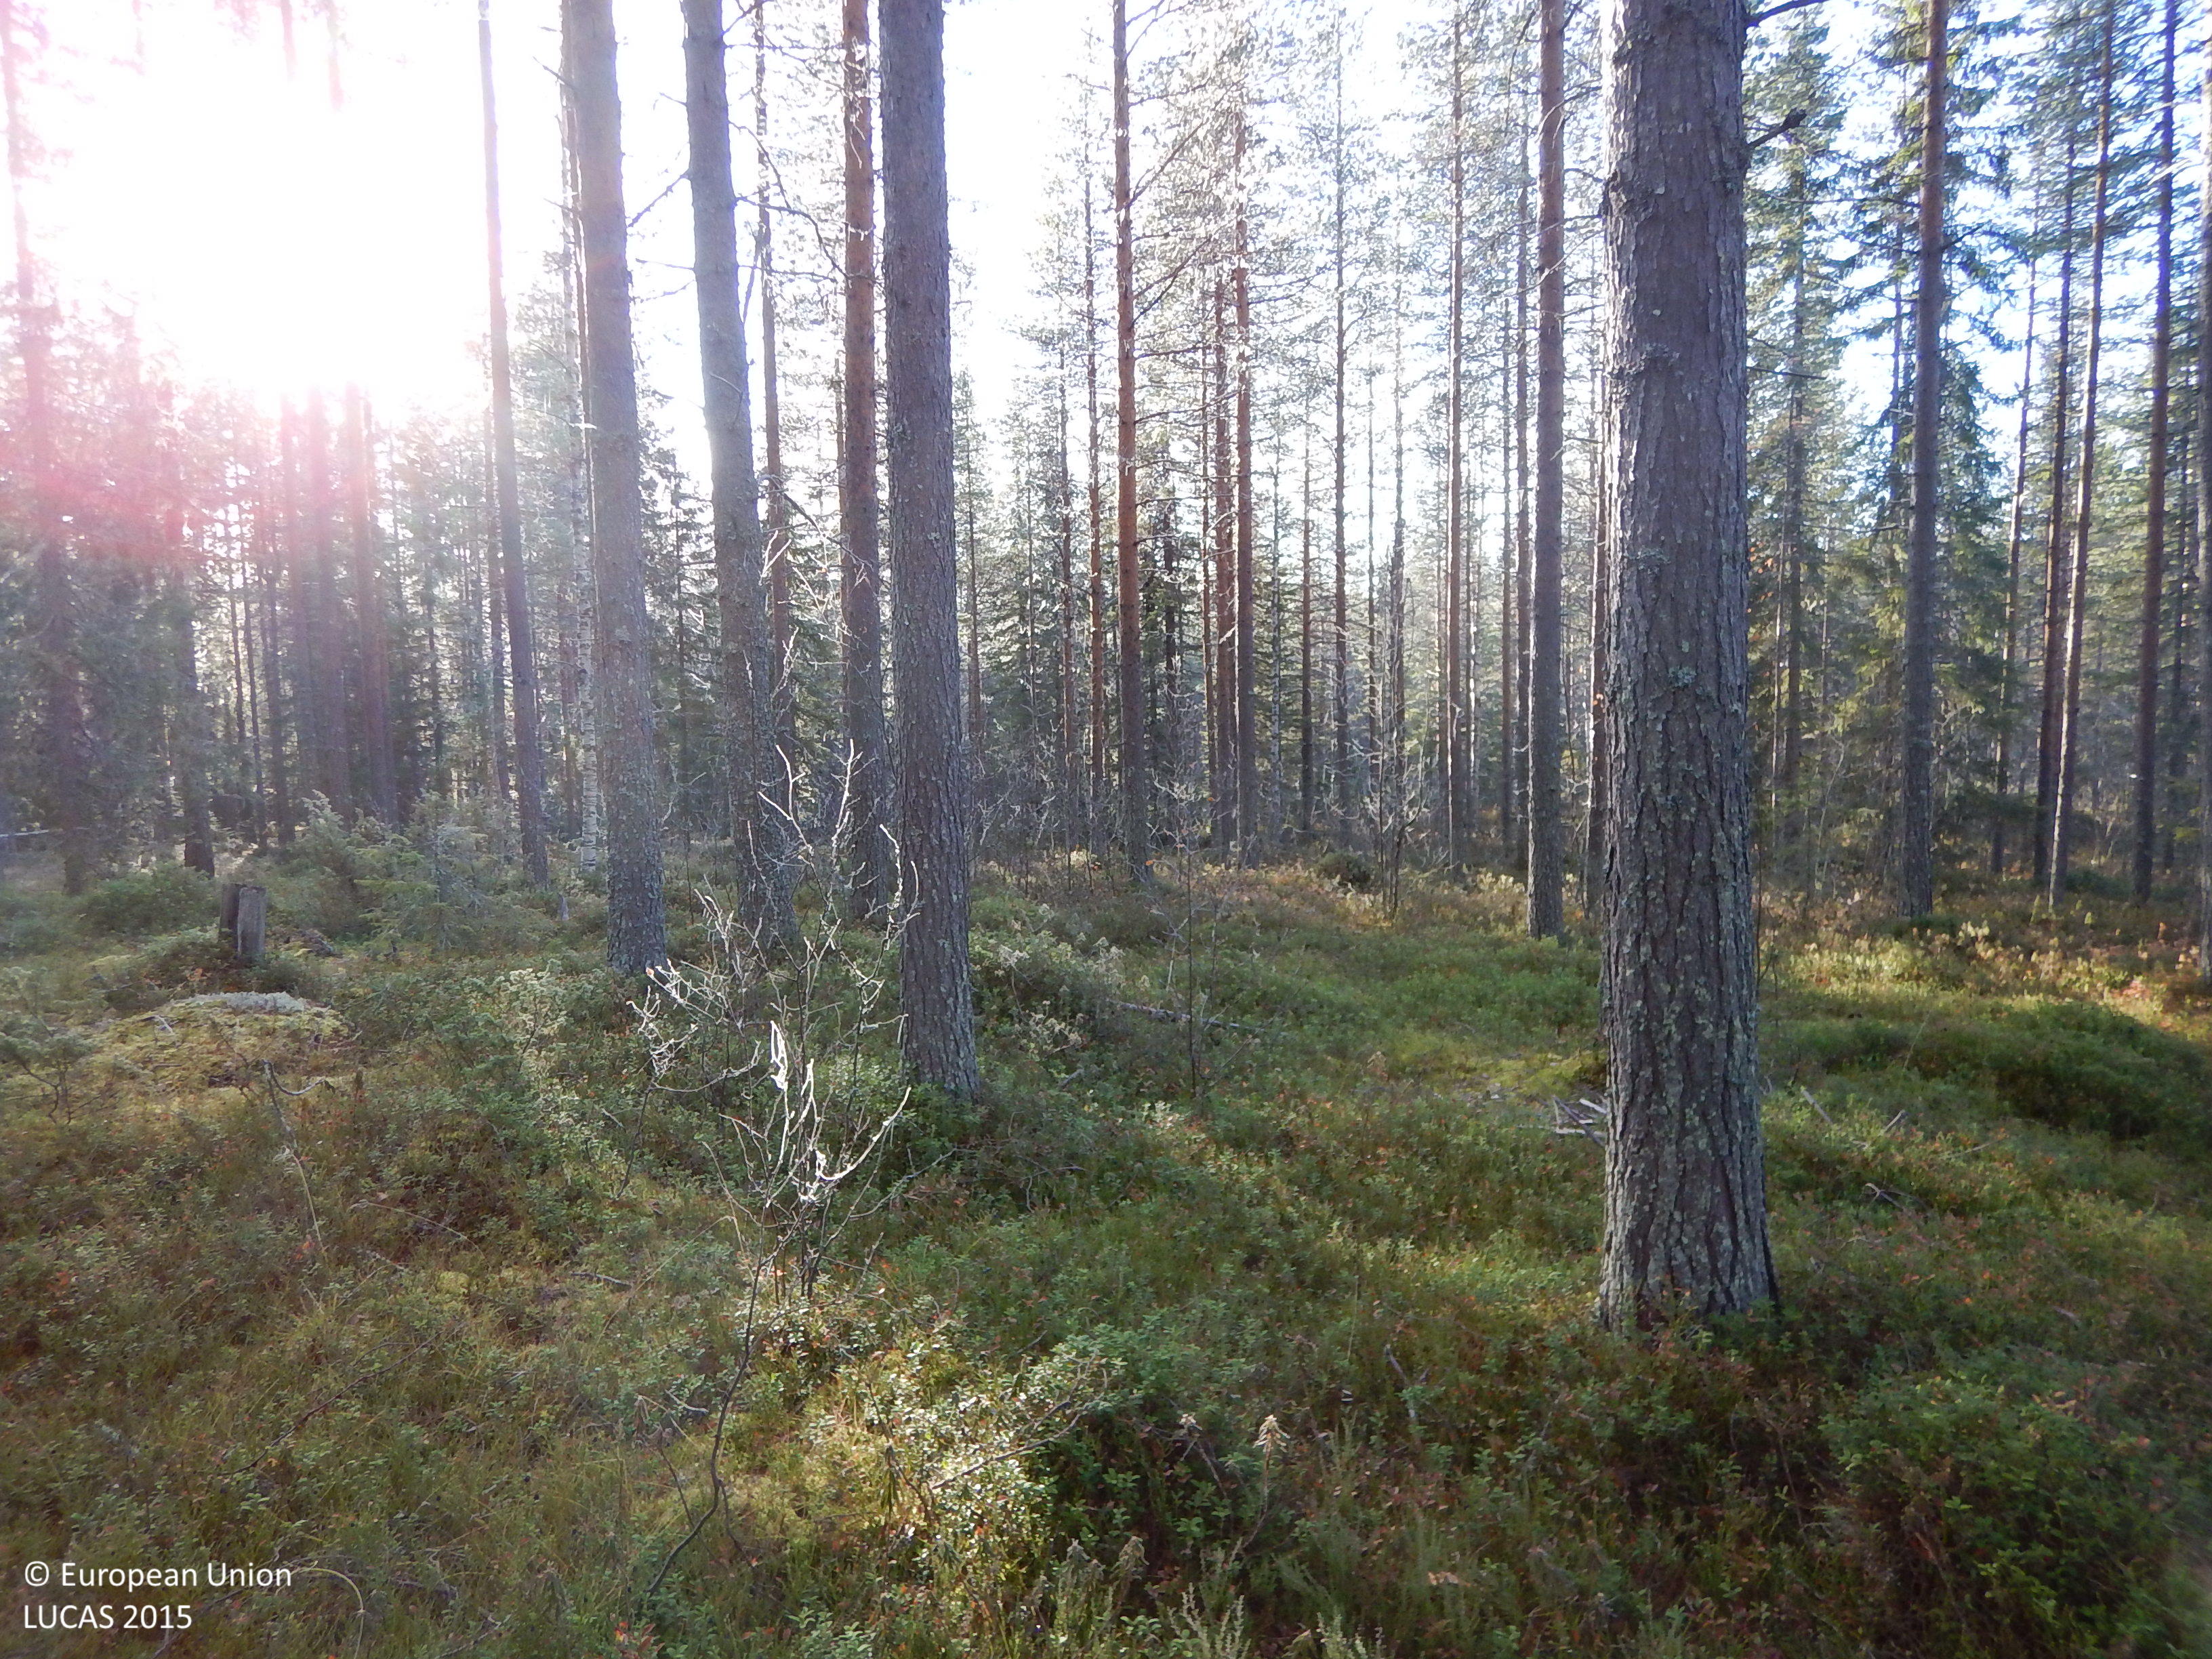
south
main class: Woodland
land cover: Pine dominated coniferous woodland
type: boreal forest
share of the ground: 50 - 75 %
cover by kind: coniferous forest trees 60 %, shrubs 20 %, herbaceous plants 10 %, lichens and mosses 10 %
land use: Forestry
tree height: > 5 m
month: October
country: SE
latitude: 65.0699
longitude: 20.2396
